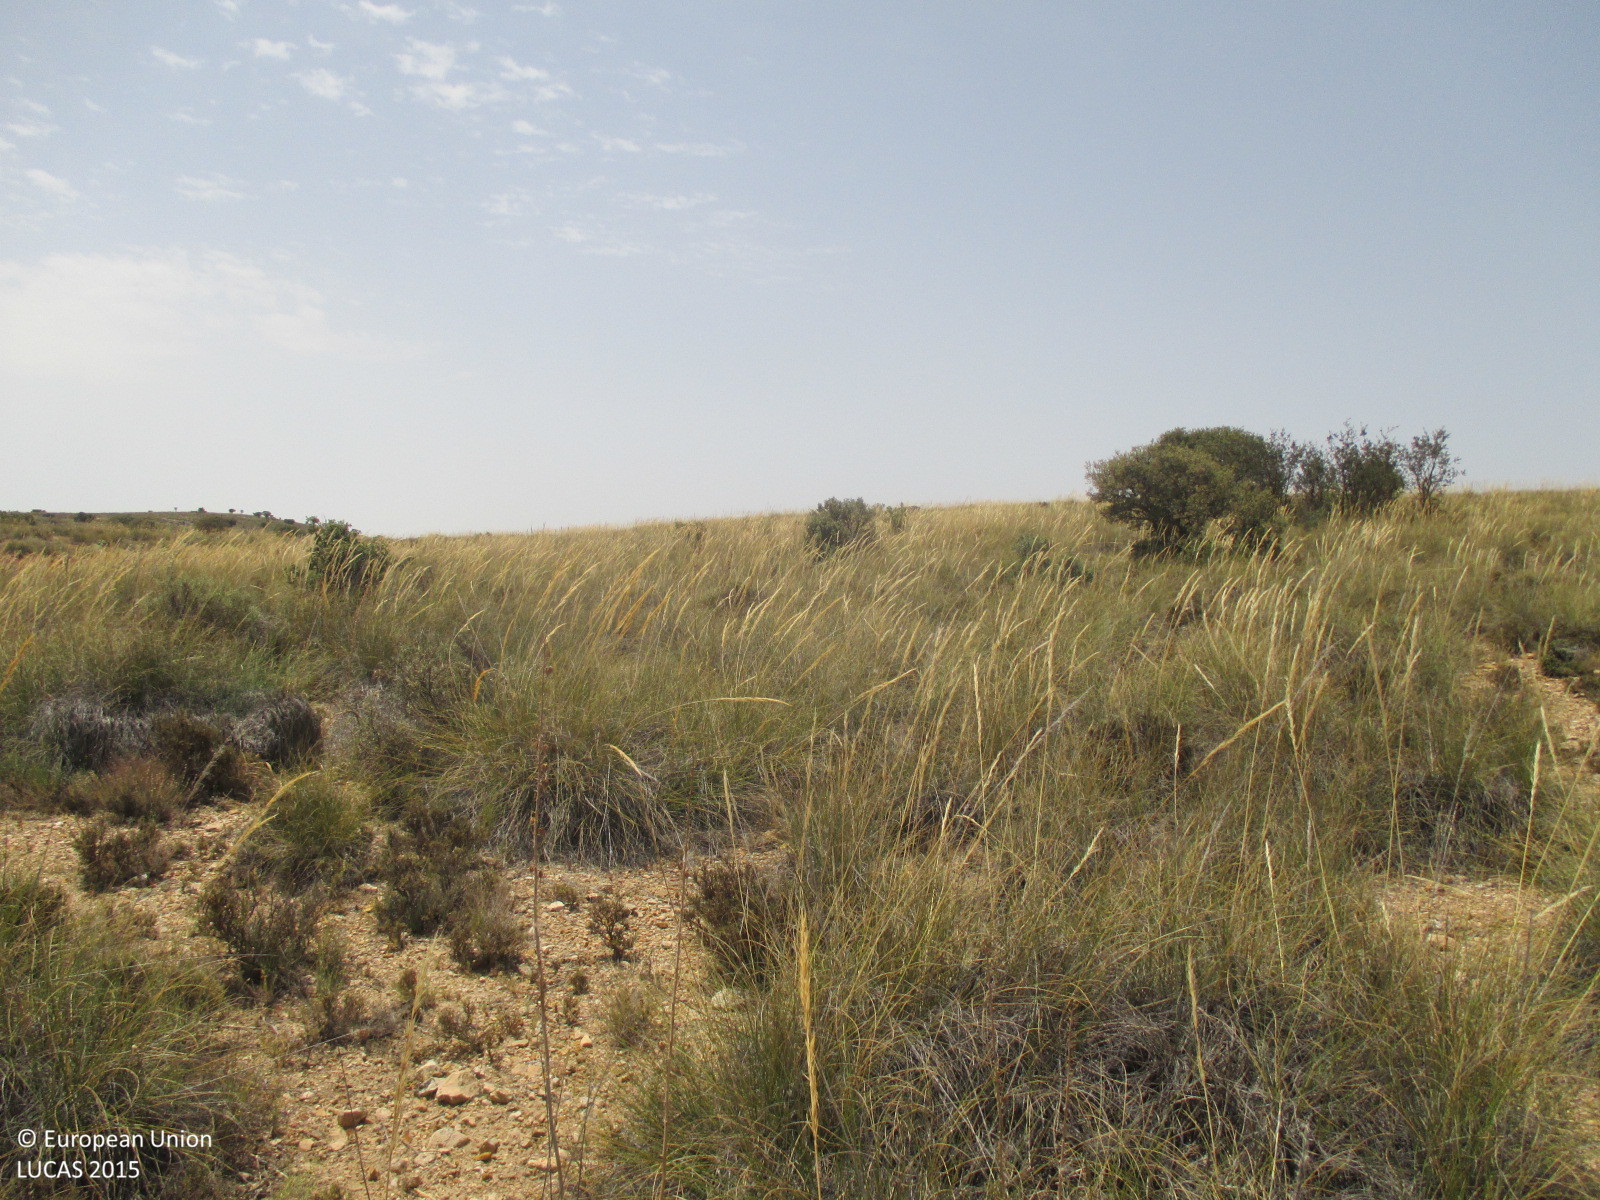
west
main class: Grassland
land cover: Grassland without tree/shrub cover
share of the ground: > 75 %
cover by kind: herbaceous plants 95 %, consolidated bare surface 5 %
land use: Semi-natural and natural areas not in use
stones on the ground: < 10 %
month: July
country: ES
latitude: 37.8619
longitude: -2.2990
